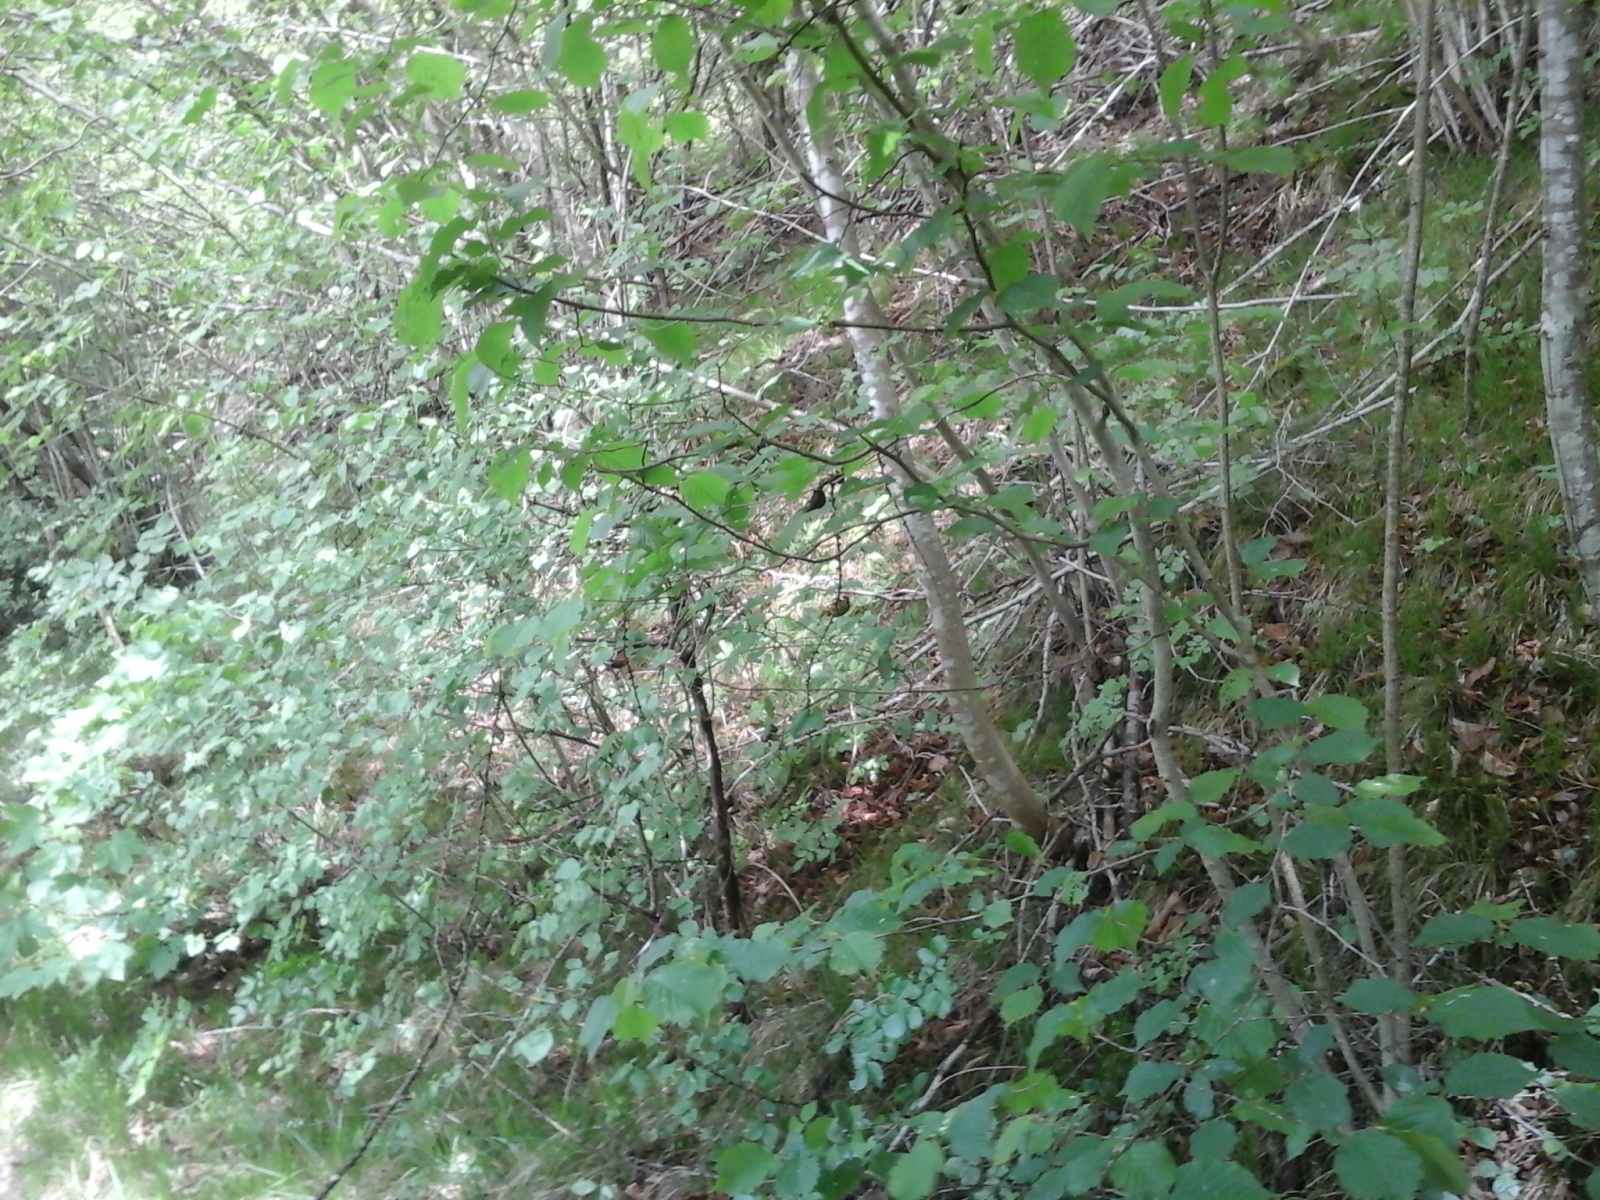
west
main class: Woodland
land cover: Other mixed woodland
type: alpine coniferous forest
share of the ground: > 75 %
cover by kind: broadleaved forest trees 75 %, coniferous forest trees 25 %
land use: Forestry
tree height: > 5 m
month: May
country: IT
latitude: 46.0424
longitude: 10.7355
